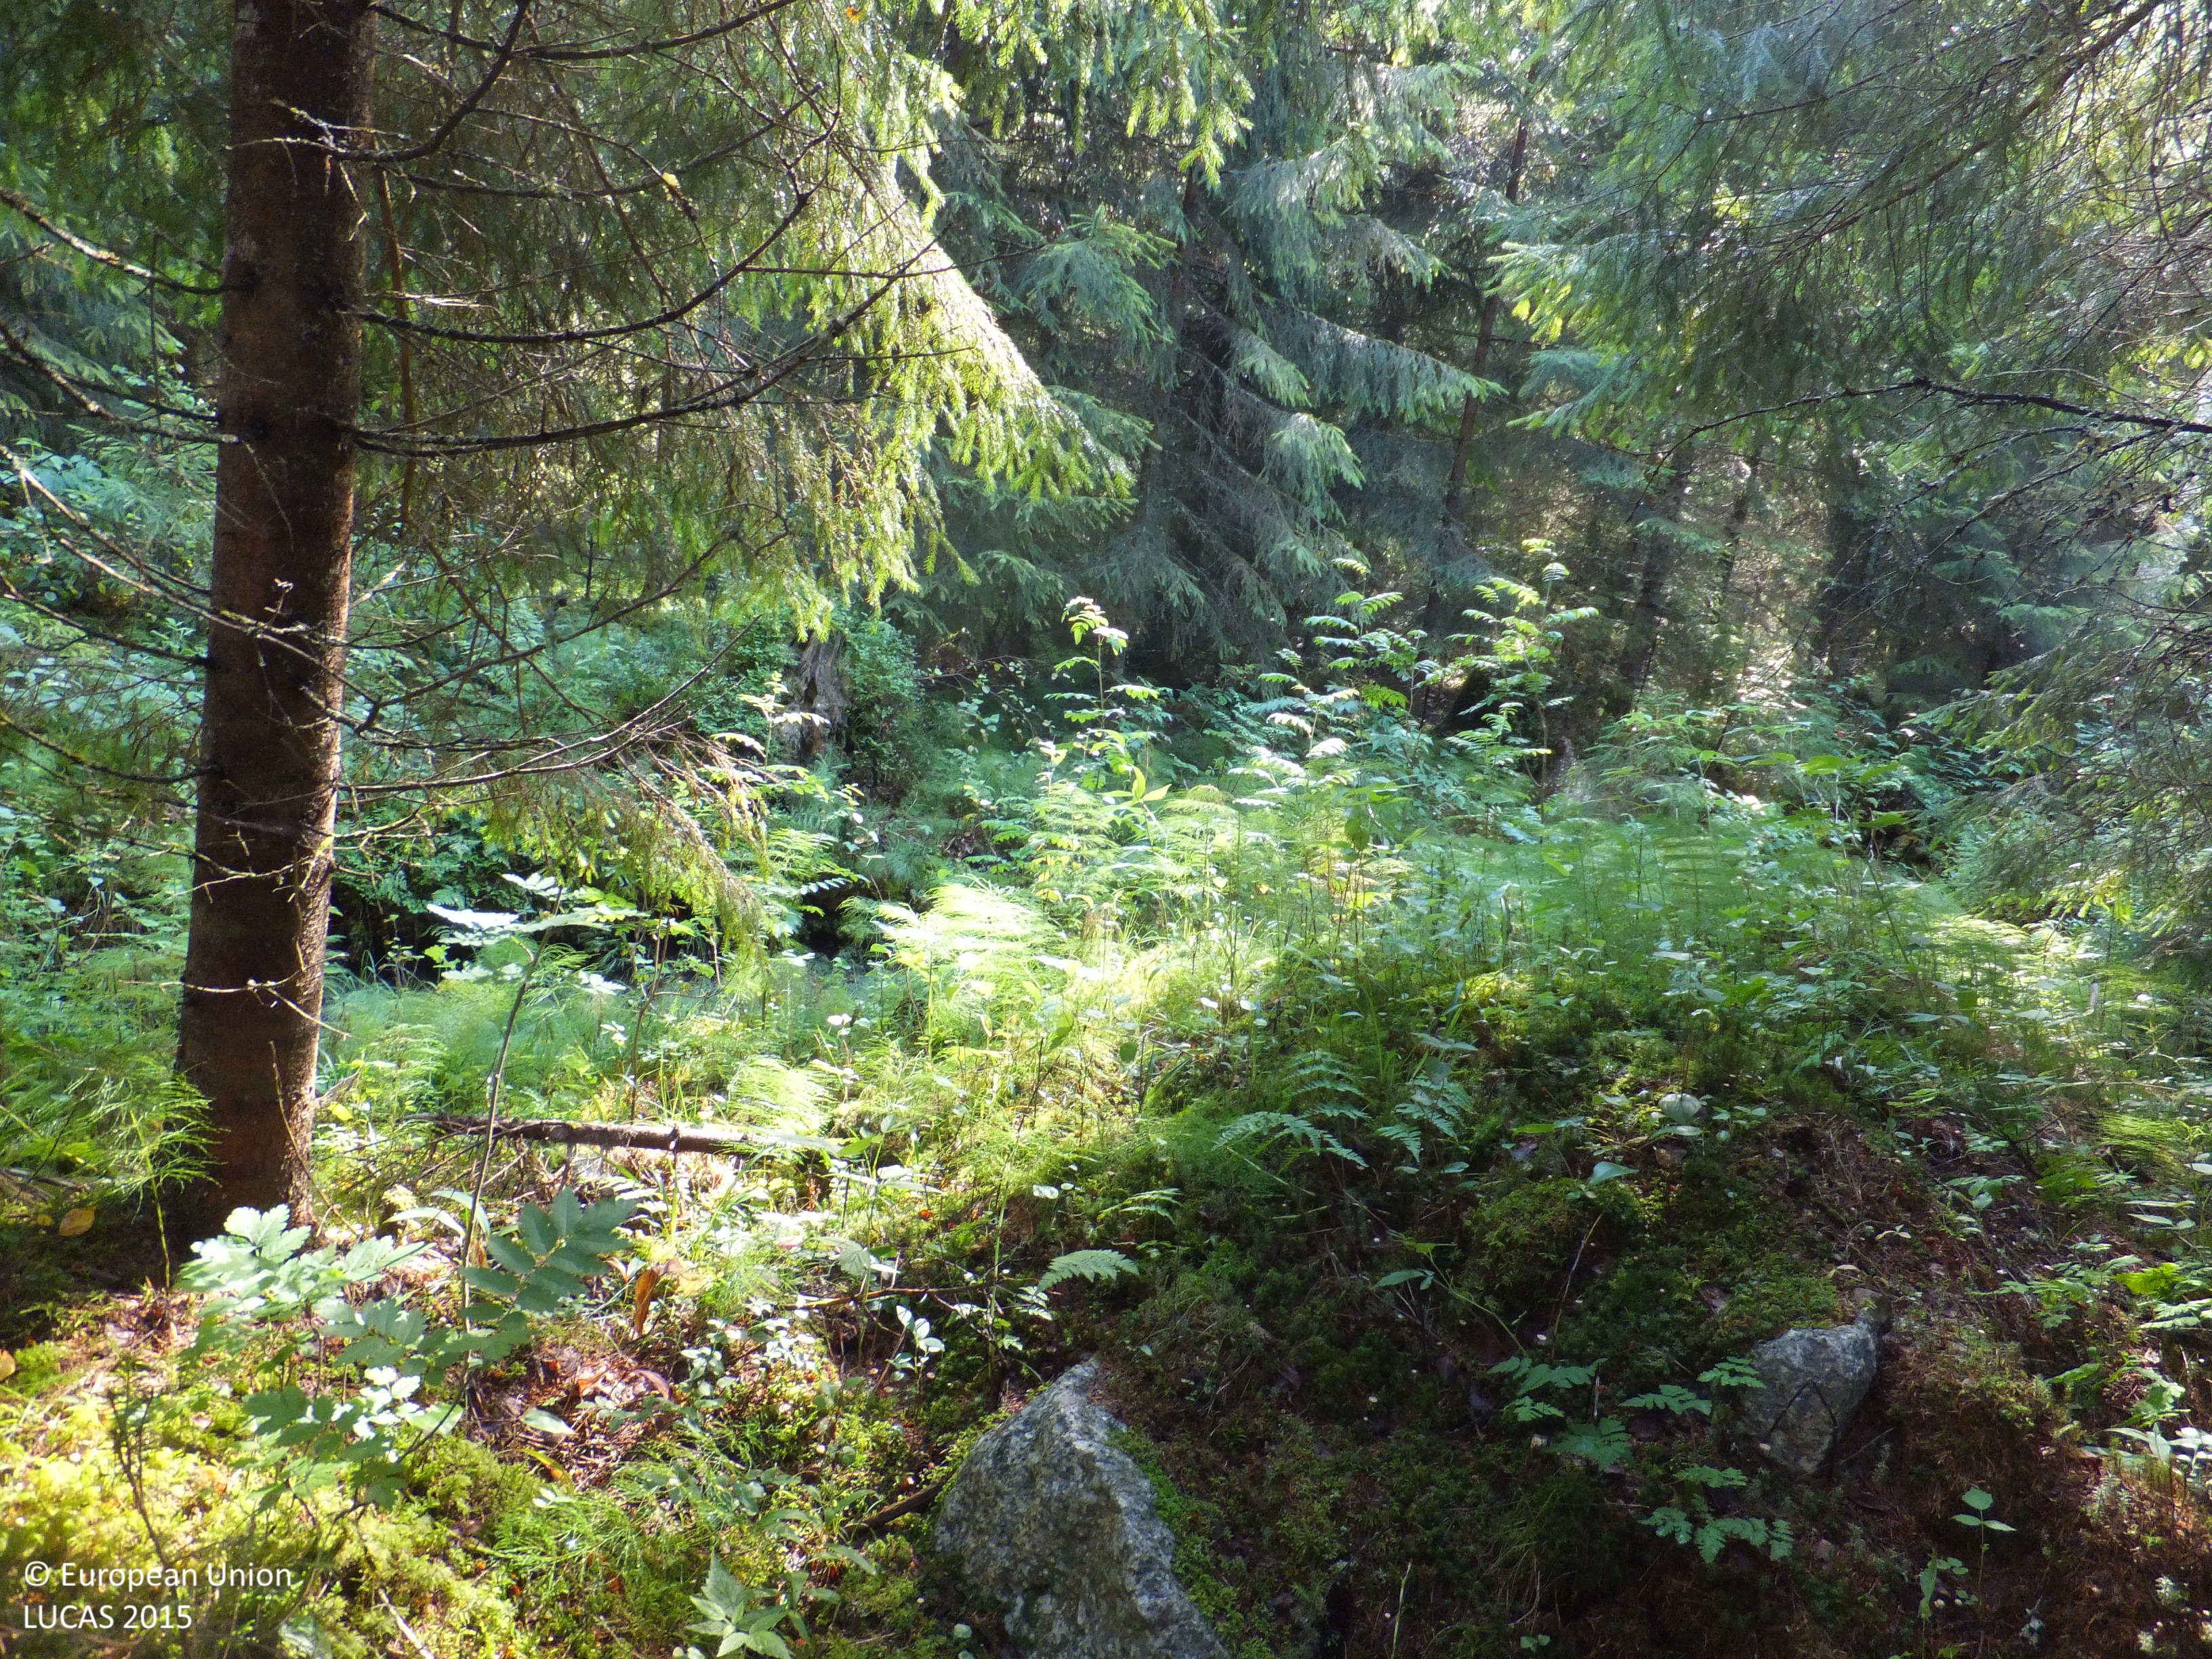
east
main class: Woodland
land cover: Spruce dominated mixed woodland
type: boreal forest
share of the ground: > 75 %
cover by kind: coniferous forest trees 55 %, broadleaved forest trees 30 %, shrubs 5 %, herbaceous plants 5 %, lichens and mosses 5 %
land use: Forestry
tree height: > 5 m
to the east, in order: Spruce dominated mixed woodland; Ditches and canals; Spruce dominated mixed woodland; Other mixed woodland; Pine dominated mixed woodland
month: August
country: FI
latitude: 63.1233
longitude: 22.1606
